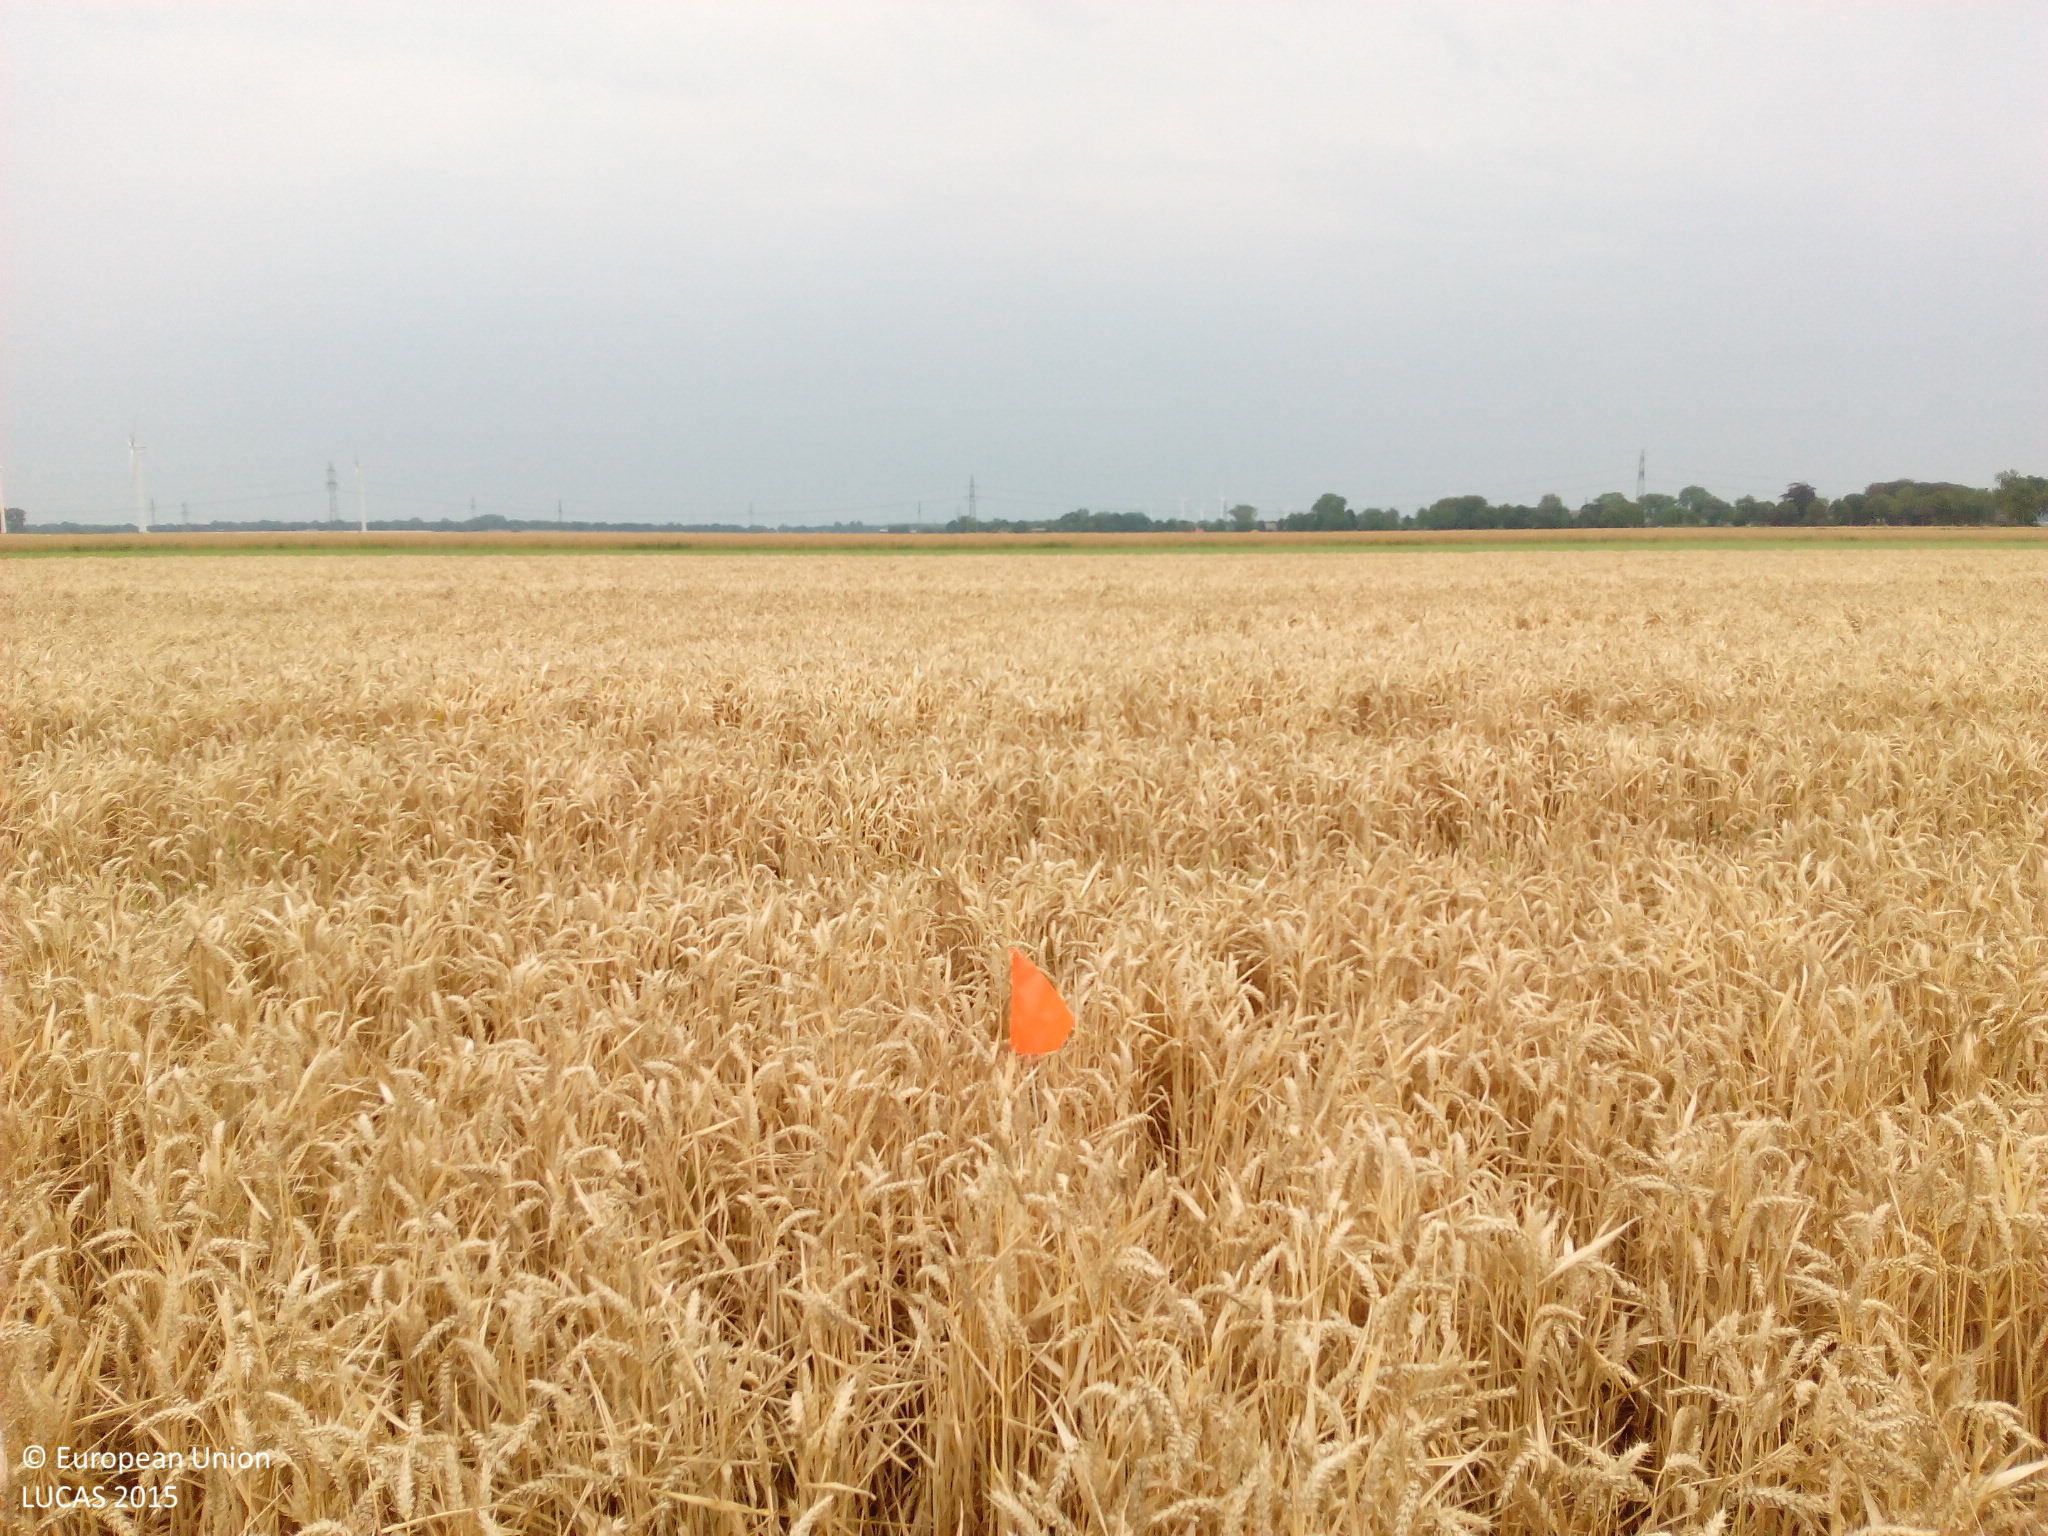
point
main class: Cropland
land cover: Common wheat
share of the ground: > 75 %
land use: Agriculture (excluding fallow land and kitchen gardens)
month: August
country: DE
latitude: 53.8145
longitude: 9.5598
